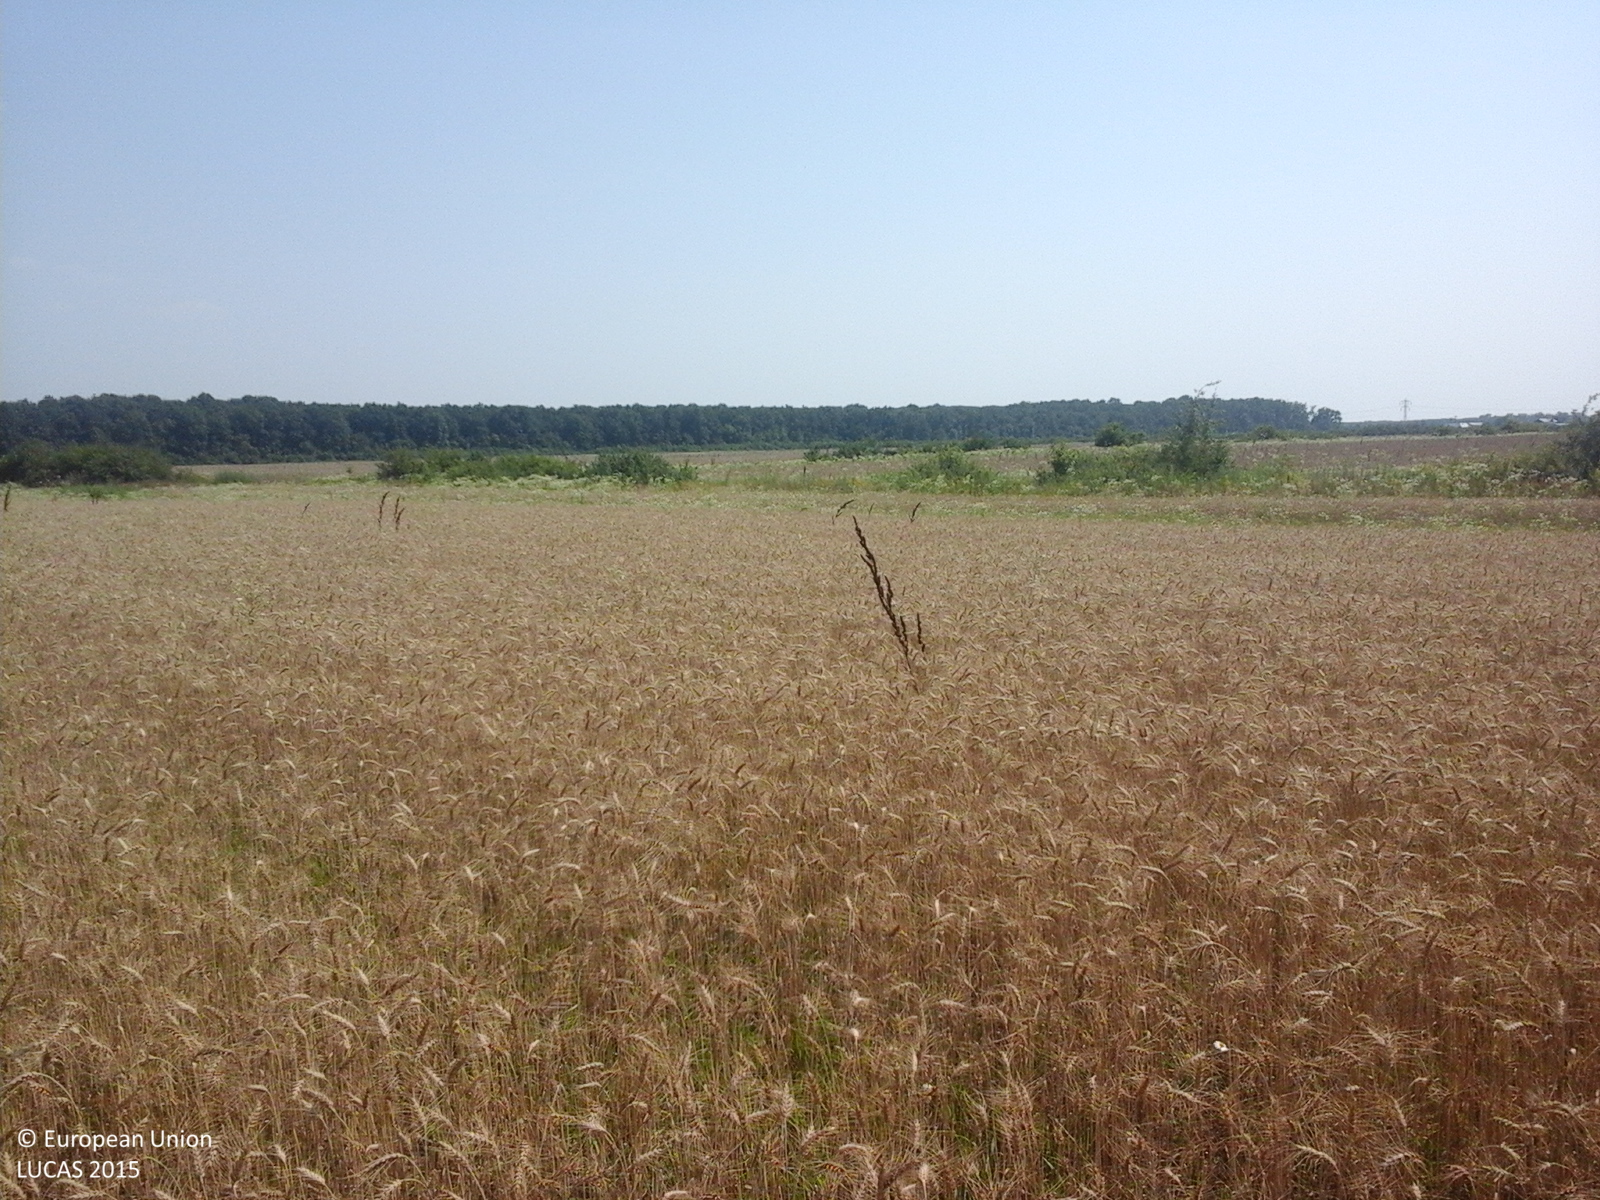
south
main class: Cropland
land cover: Nurseries
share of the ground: 10 - 25 %
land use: Forestry
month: July
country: RO
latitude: 44.8360
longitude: 25.5672
